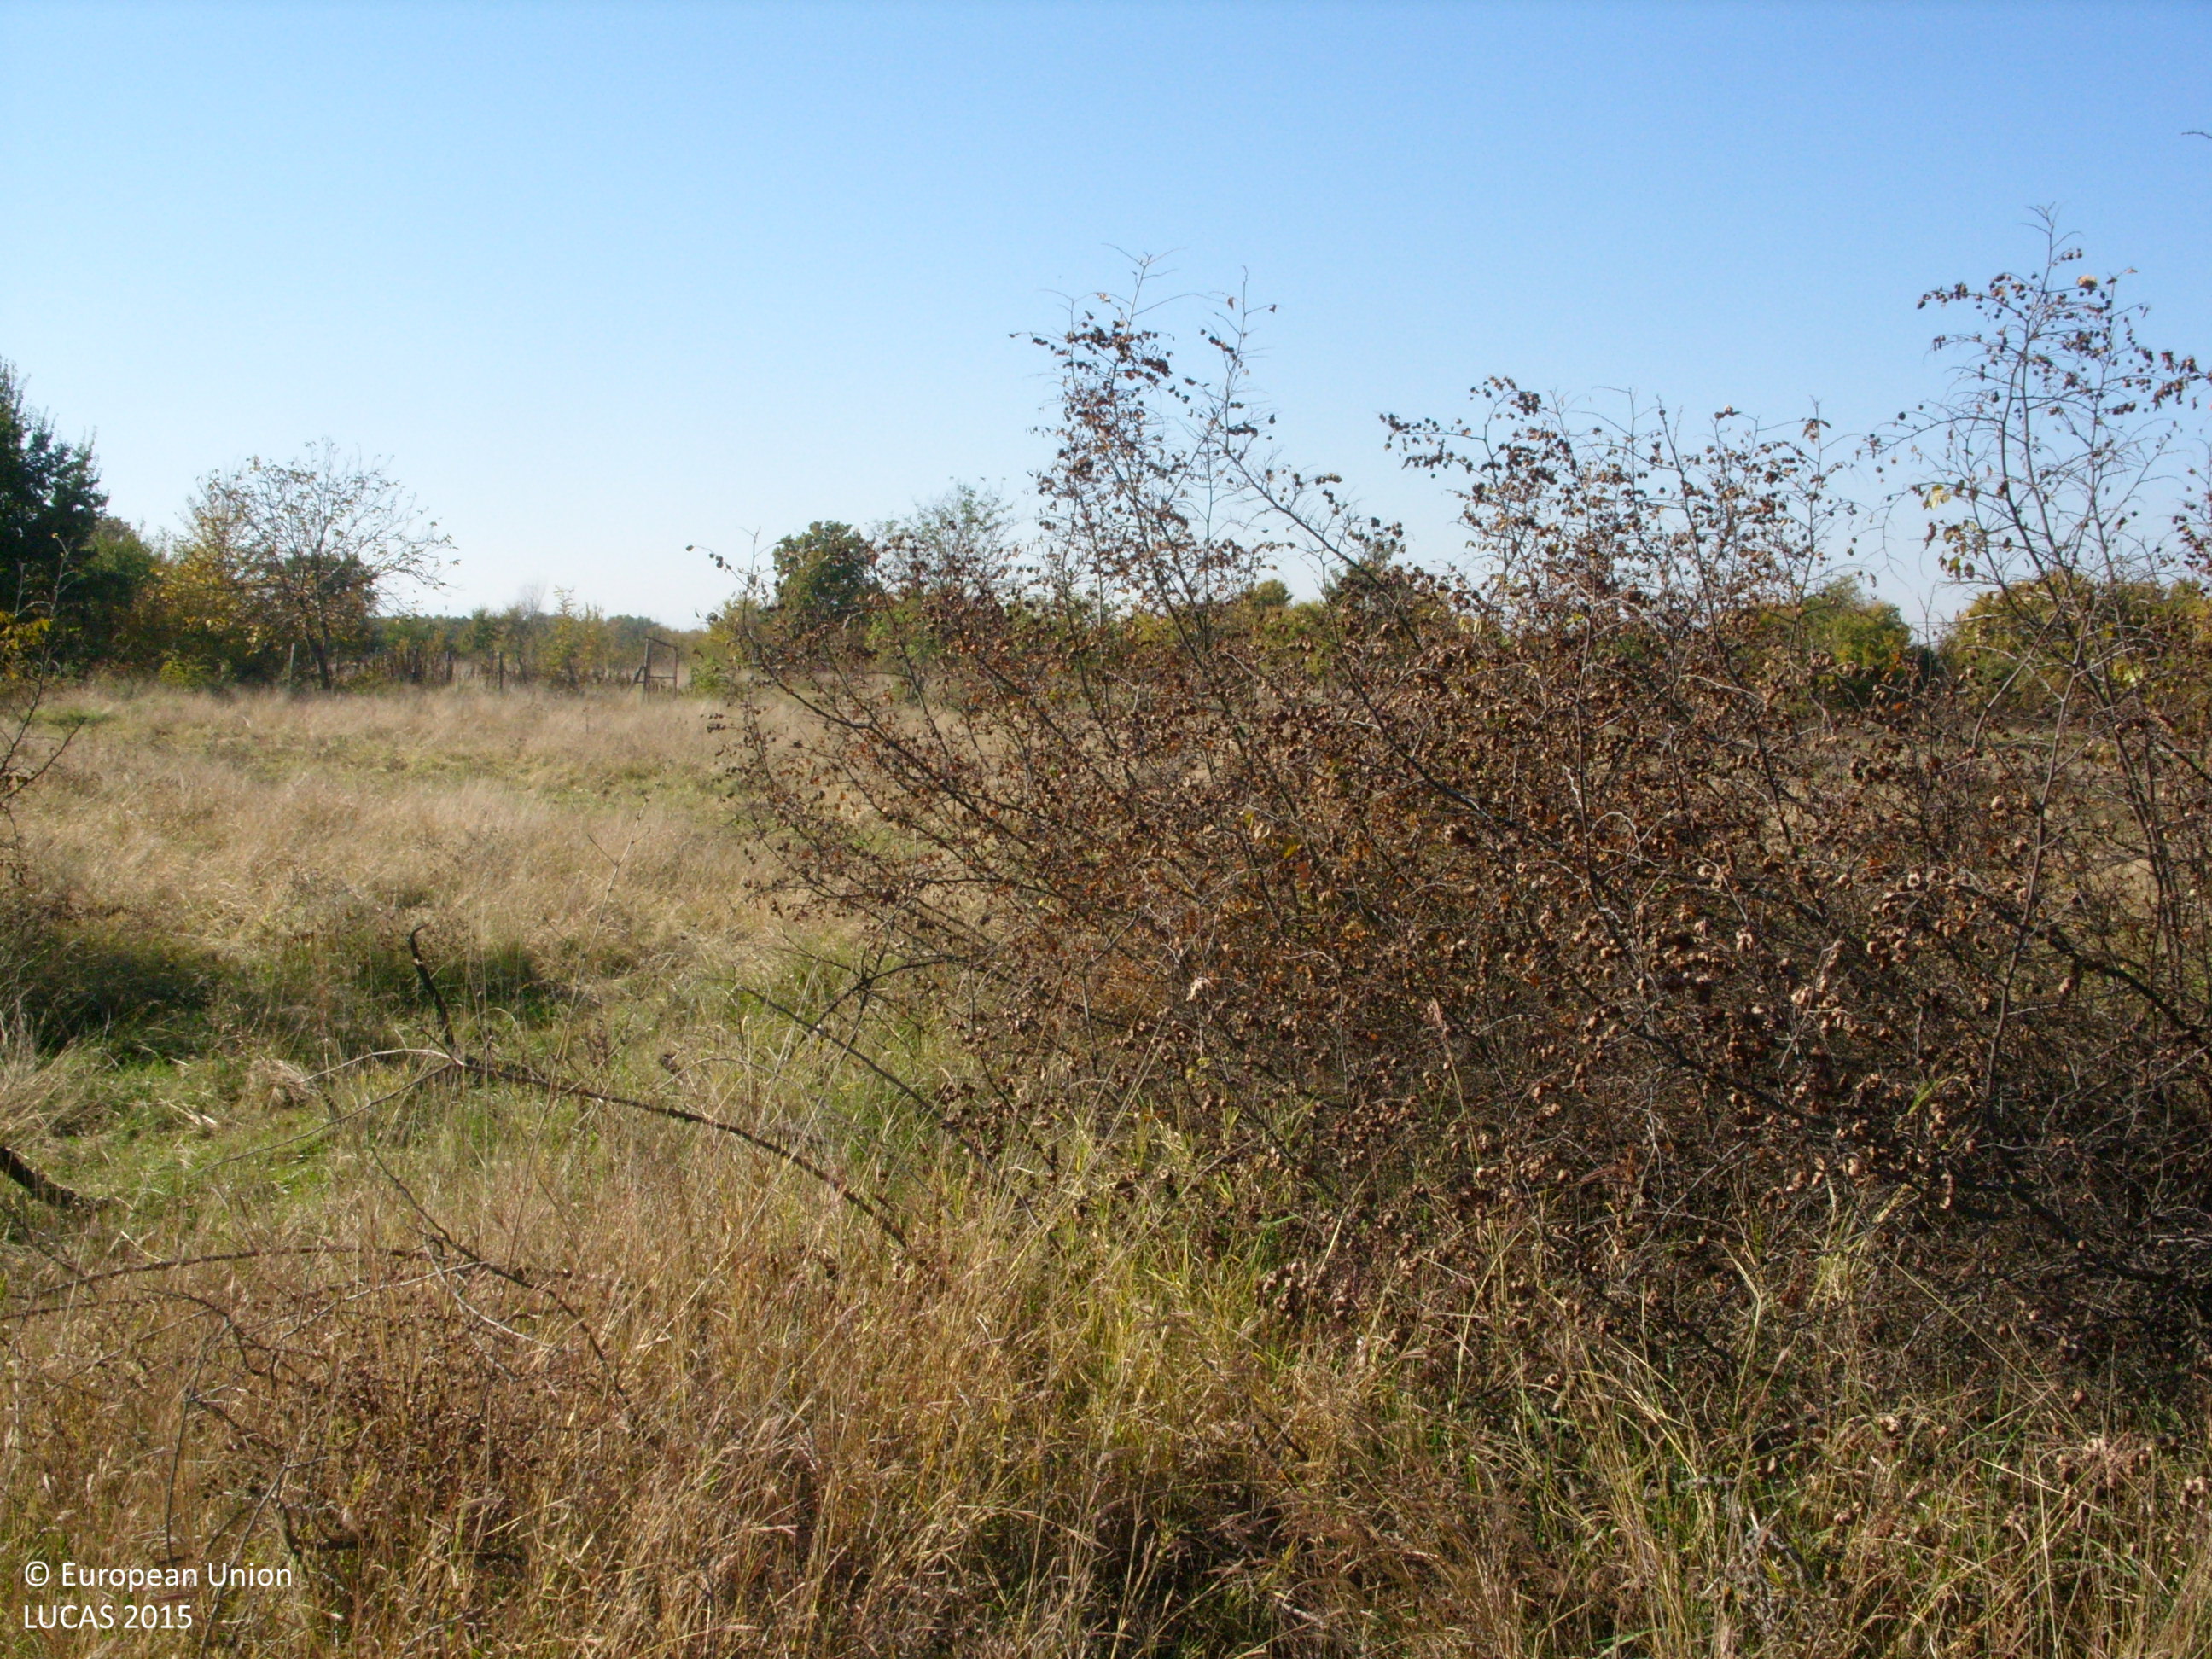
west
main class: Grassland
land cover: Grassland with sparse tree/shrub cover
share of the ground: > 75 %
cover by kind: herbaceous plants 85 %, shrubs 10 %, broadleaved forest trees 5 %
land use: Agriculture (excluding fallow land and kitchen gardens)
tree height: > 5 m
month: November
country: BG
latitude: 42.3366
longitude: 24.9989
